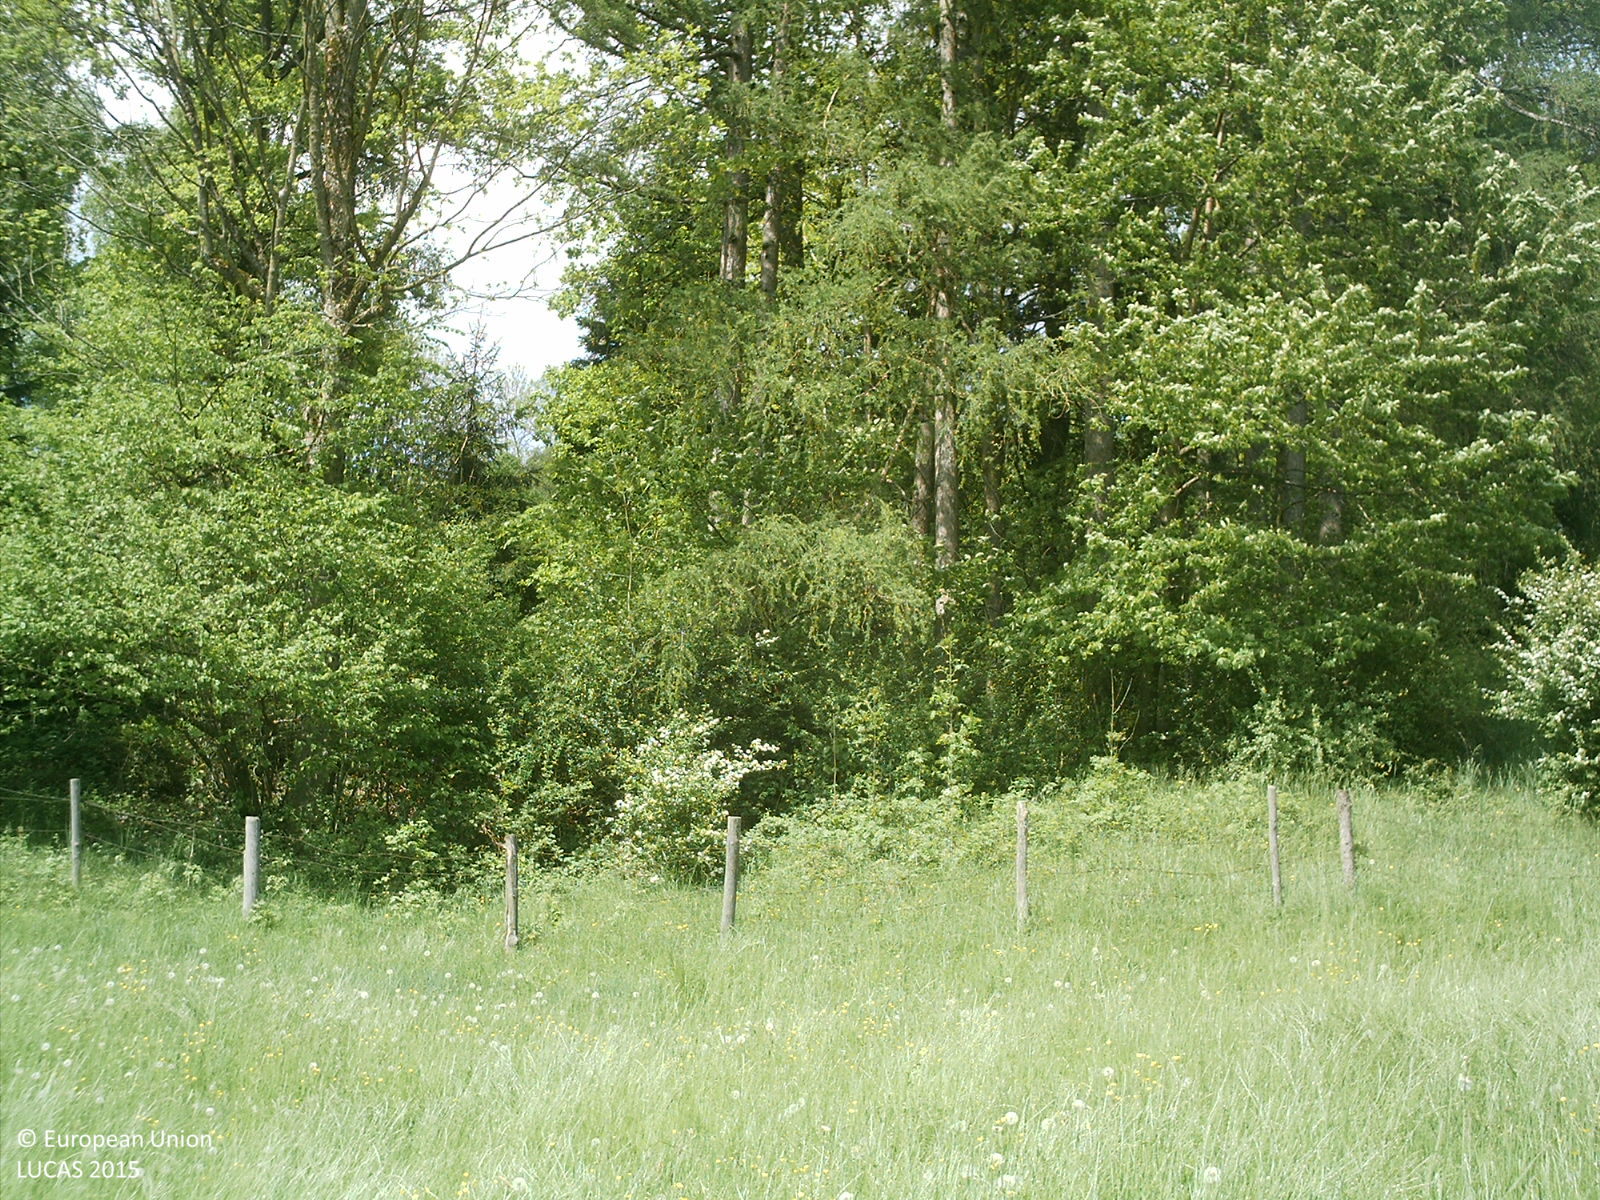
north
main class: Grassland
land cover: Grassland without tree/shrub cover
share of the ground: > 75 %
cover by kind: herbaceous plants 100 %
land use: Agriculture (excluding fallow land and kitchen gardens)
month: May
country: AT
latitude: 47.9118
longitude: 14.1338
